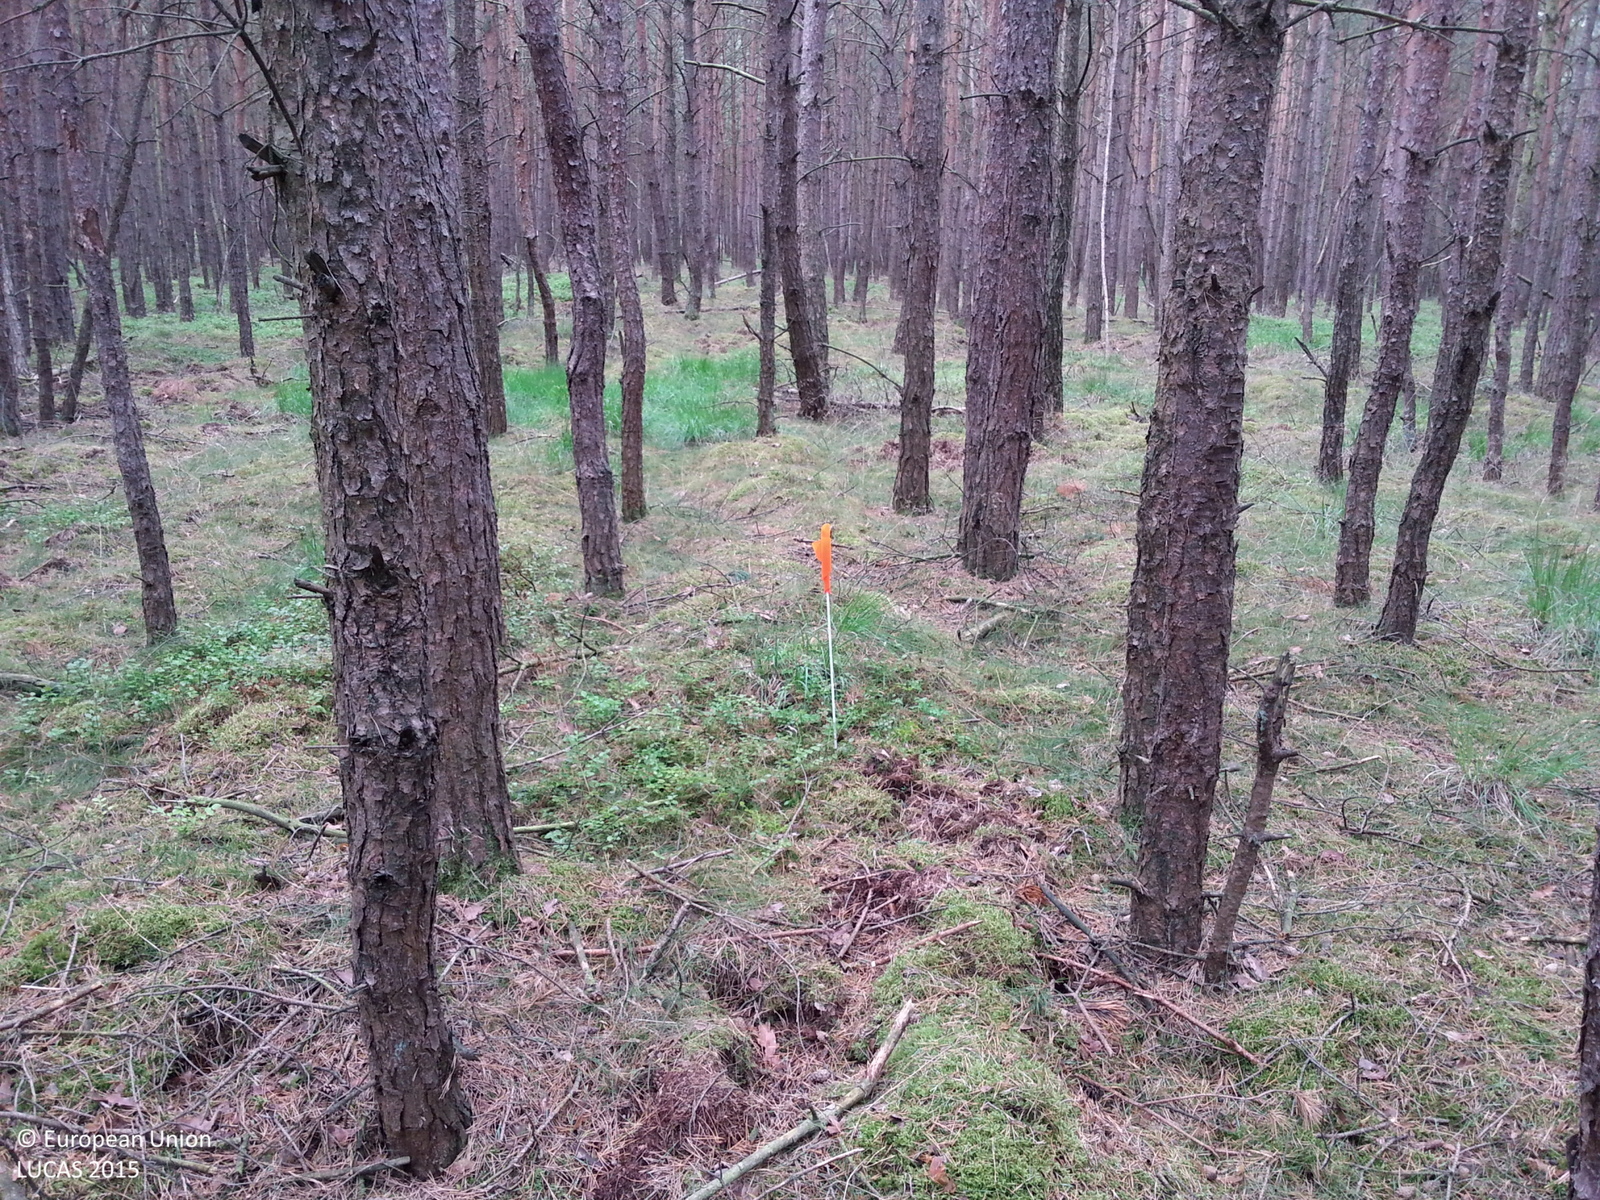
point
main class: Woodland
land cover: Pine dominated coniferous woodland
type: hemiboreal forest and nemoral coniferous forest and mixed broadleaved-coniferous forest
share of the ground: 50 - 75 %
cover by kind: coniferous forest trees 60 %, herbaceous plants 30 %, lichens and mosses 10 %
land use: Forestry
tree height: > 5 m
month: July
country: DE
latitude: 53.1588
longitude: 11.5099
